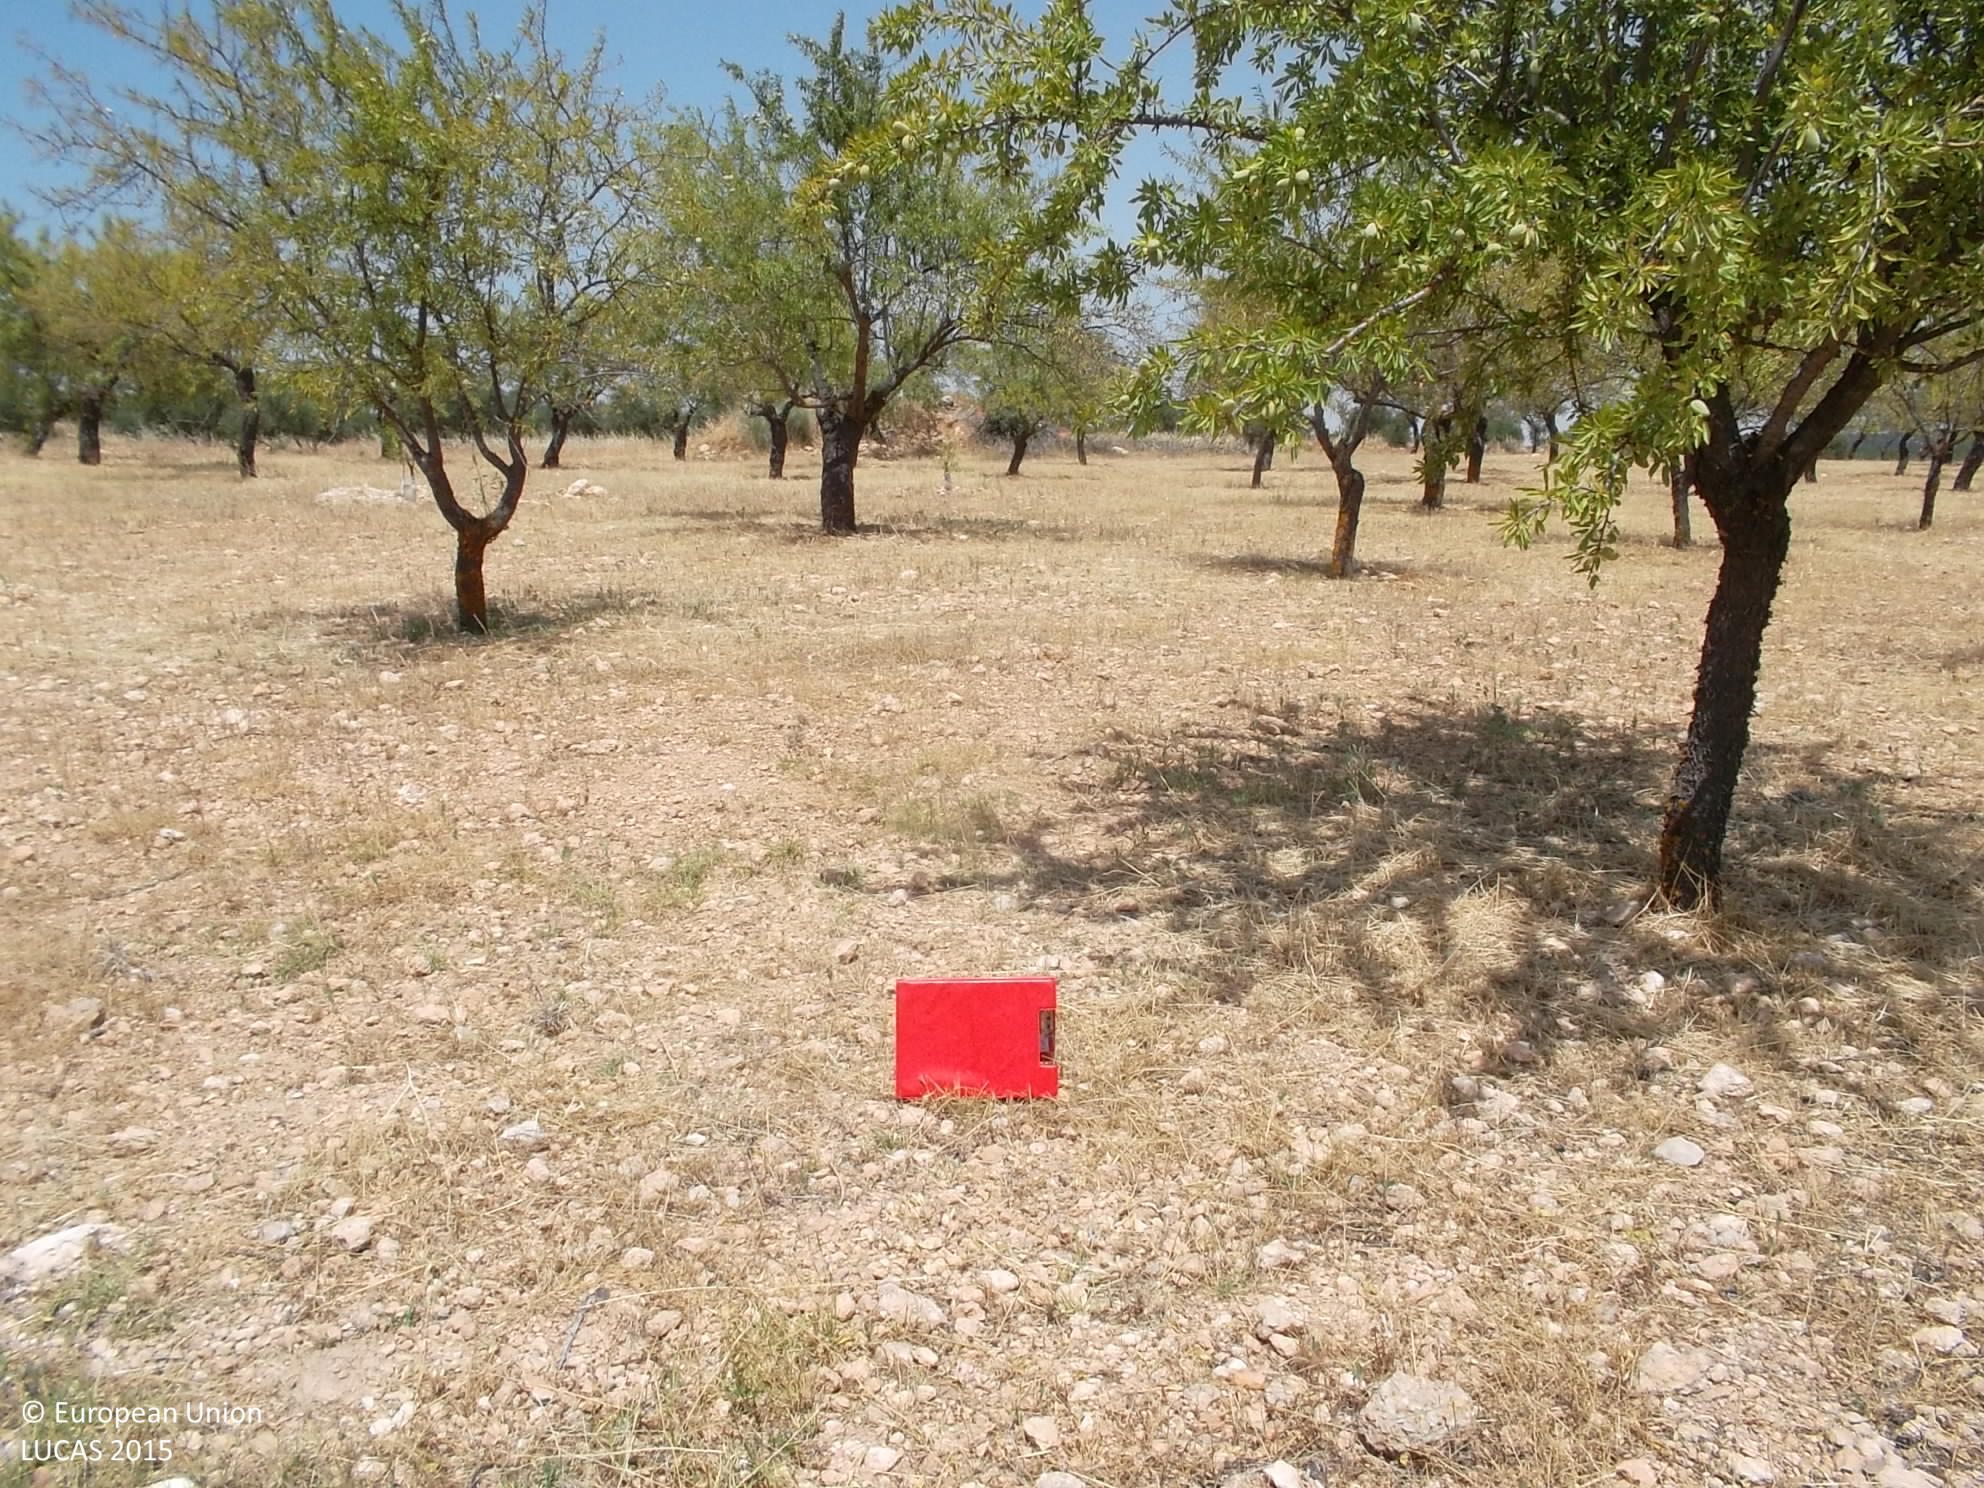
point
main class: Cropland
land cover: Nuts trees
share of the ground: 25 - 50 %
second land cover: Spontaneously vegetated surfaces
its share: > 75 %
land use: Agriculture (excluding fallow land and kitchen gardens)
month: June
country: ES
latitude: 37.7218
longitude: -2.9366
